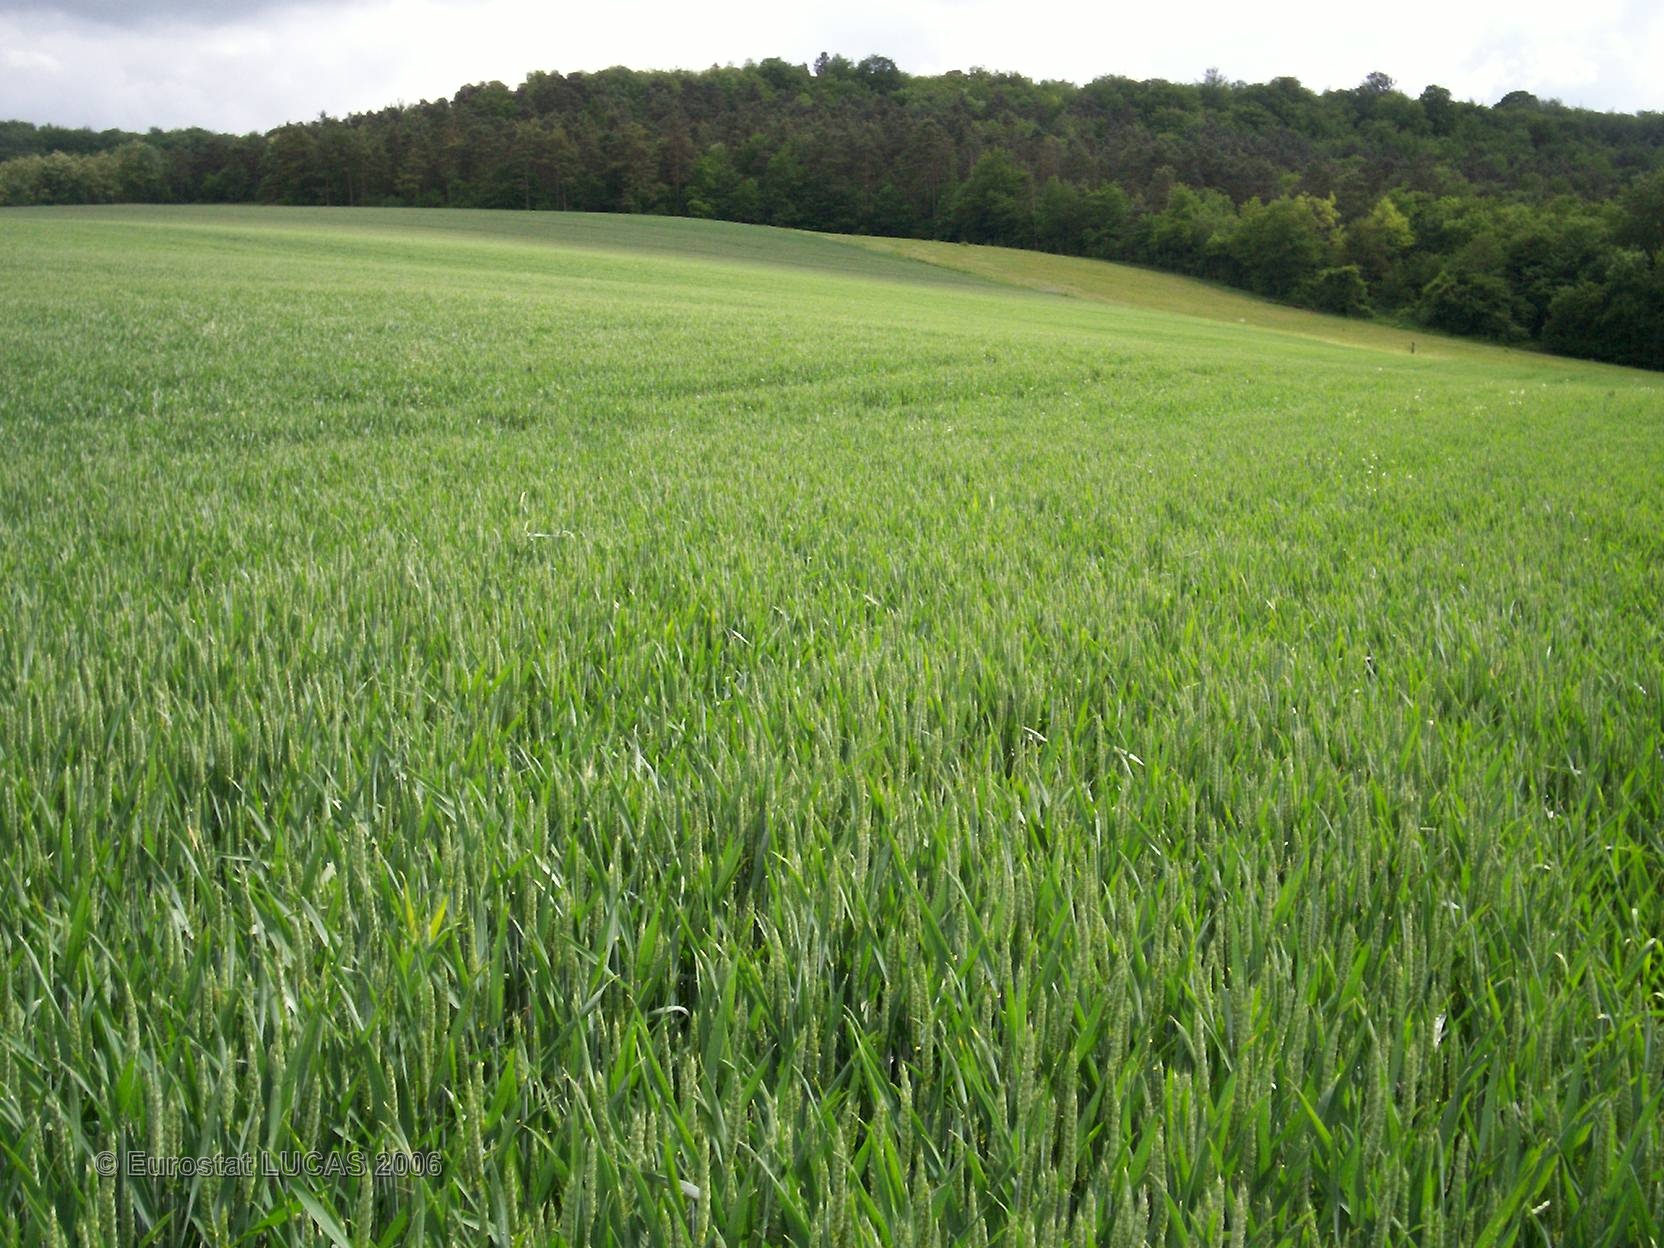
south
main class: Cropland
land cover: Common wheat
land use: Agriculture (excluding fallow land and kitchen gardens)
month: May
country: FR
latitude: 48.2394
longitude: 4.6795
